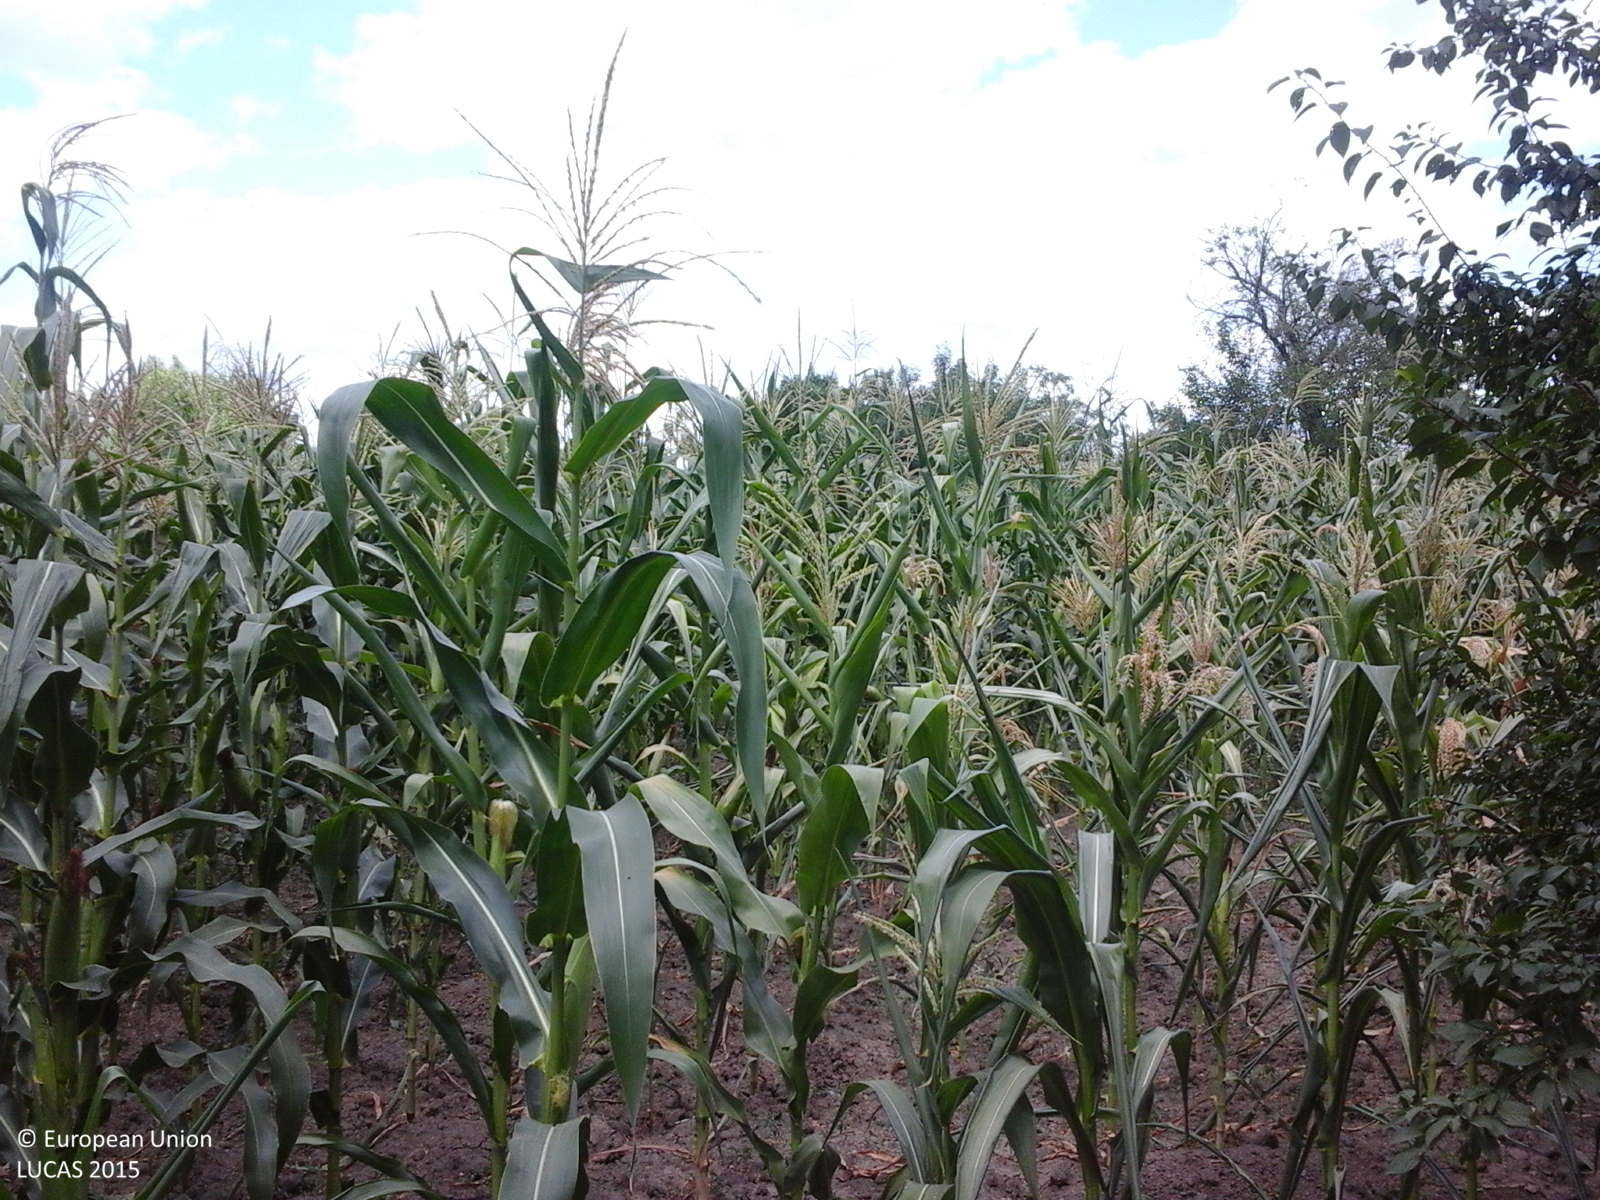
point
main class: Cropland
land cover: Maize
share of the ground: > 75 %
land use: Agriculture (excluding fallow land and kitchen gardens)
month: July
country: RO
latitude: 46.1950
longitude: 27.5380
